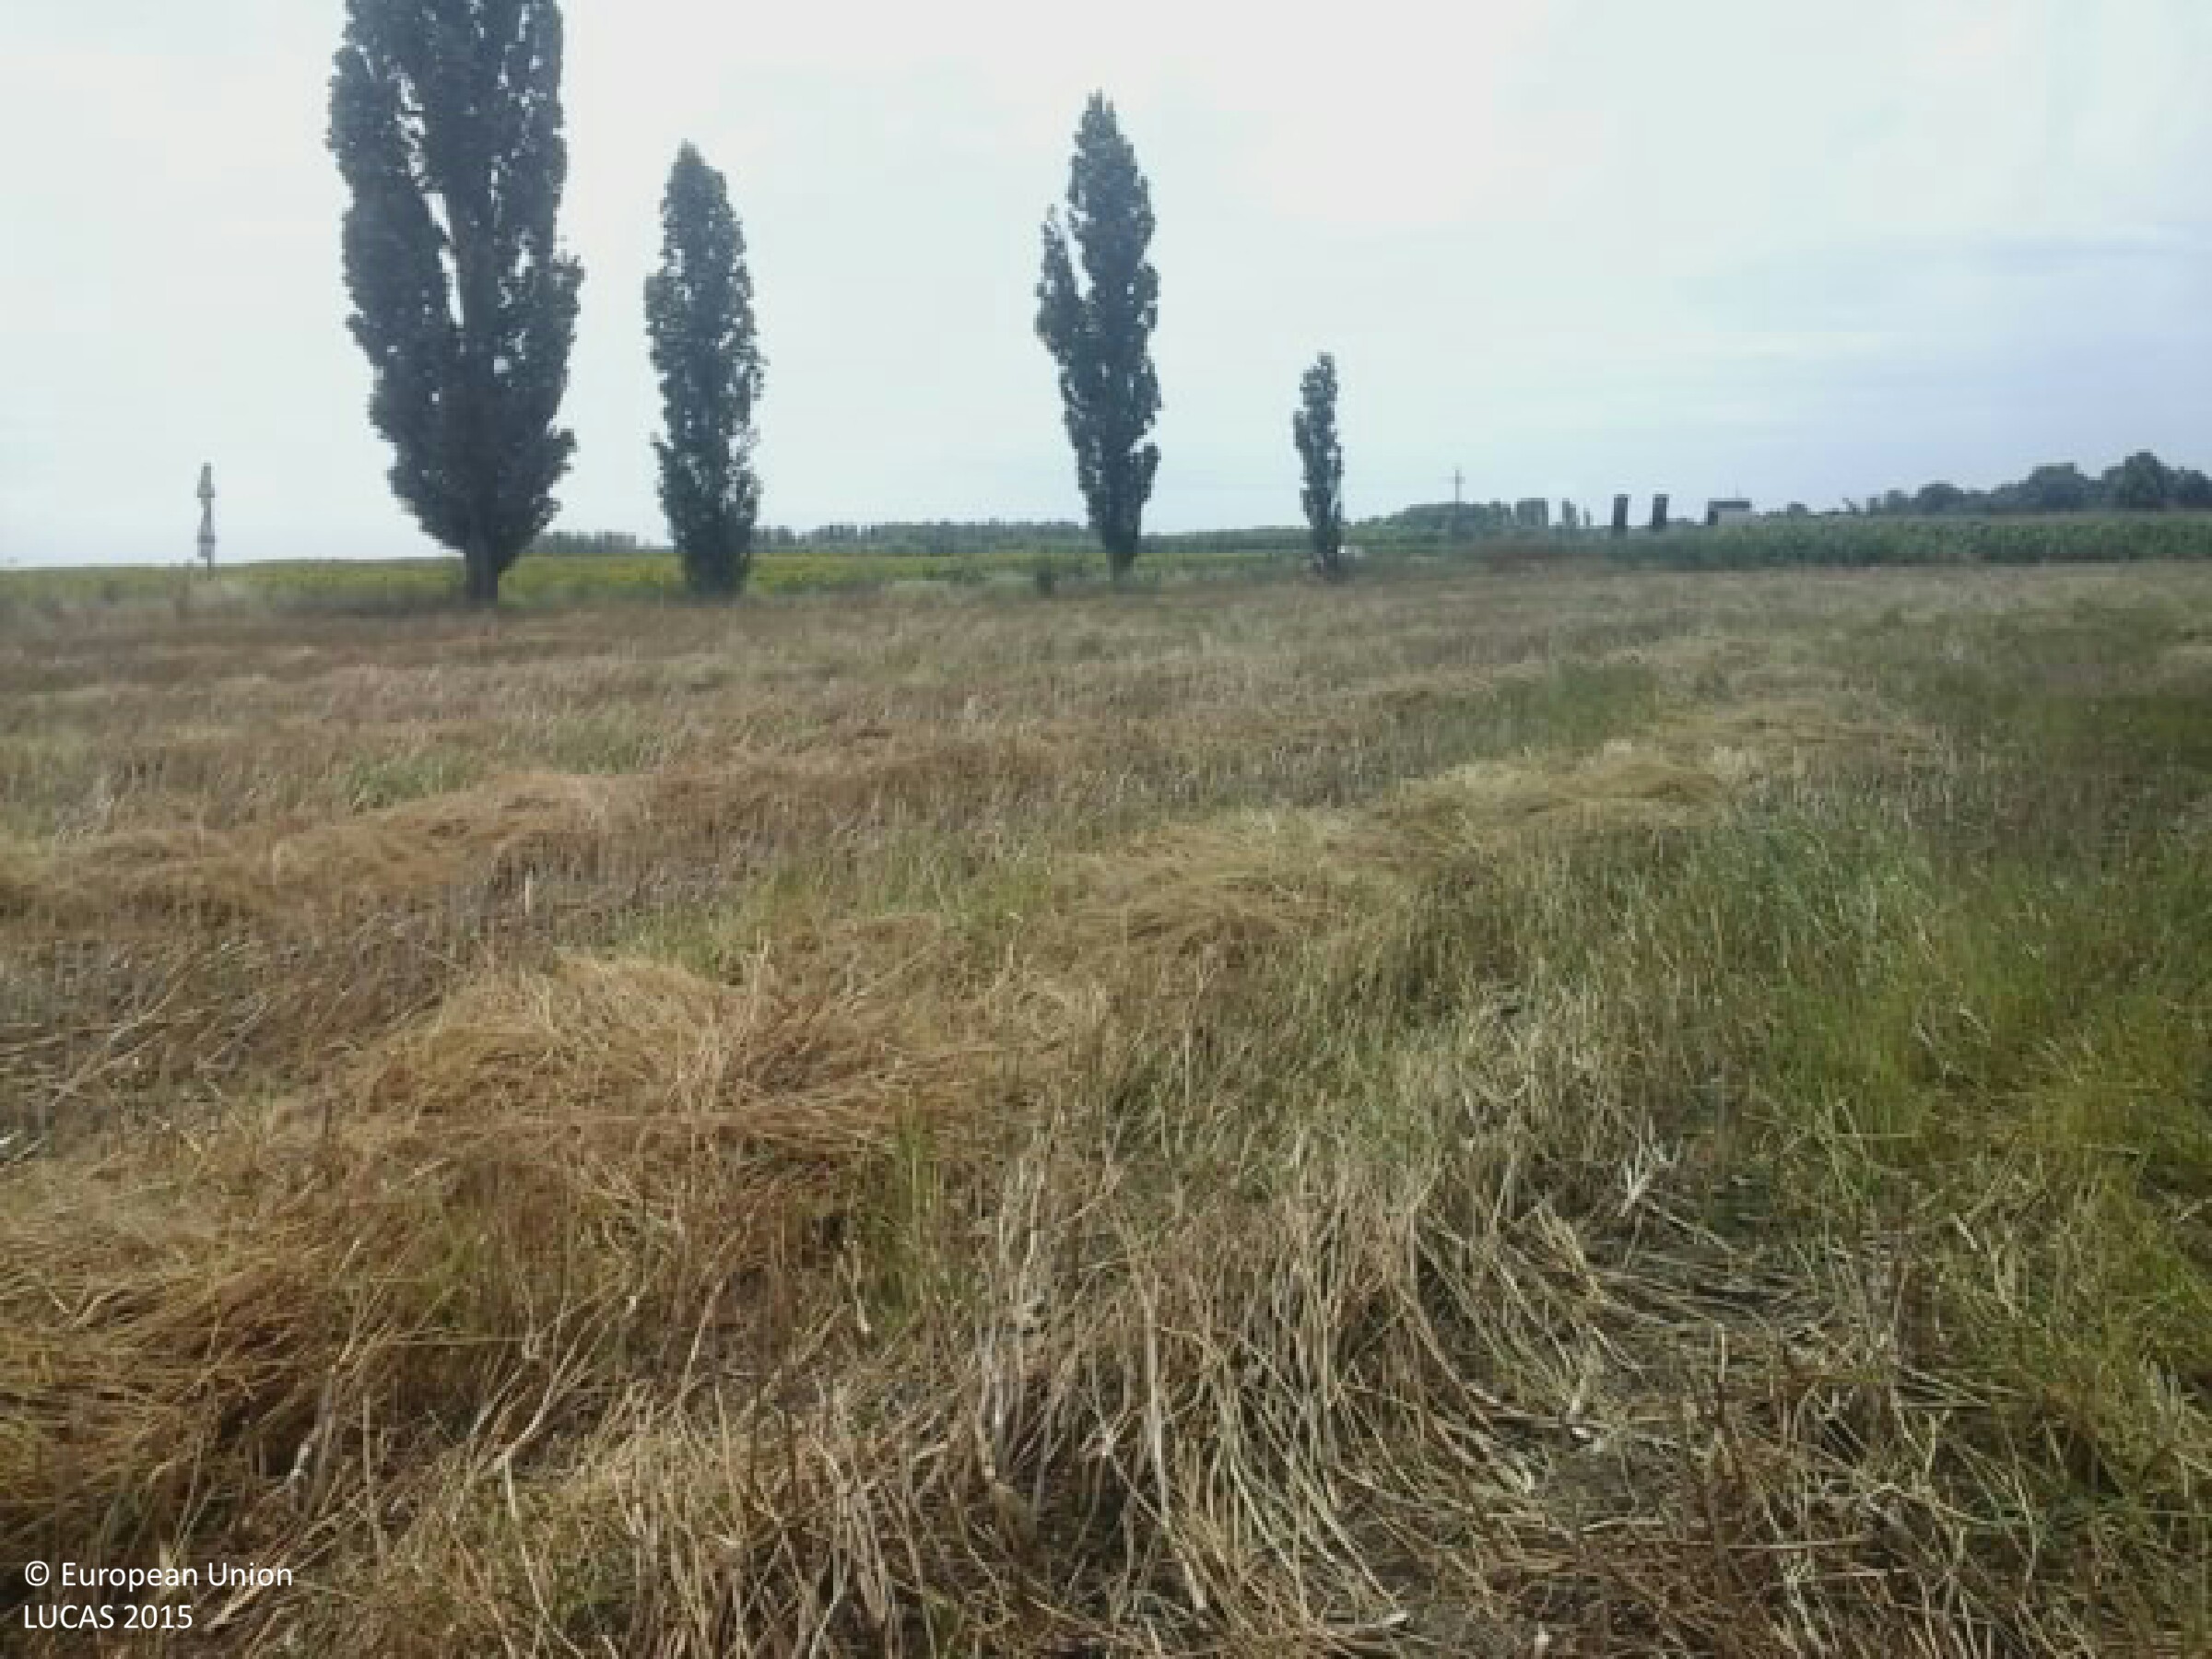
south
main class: Cropland
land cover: Rape and turnip rape
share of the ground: 25 - 50 %
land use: Agriculture (excluding fallow land and kitchen gardens)
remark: Harvested field
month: July
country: HU
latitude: 47.1489
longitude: 18.9970
